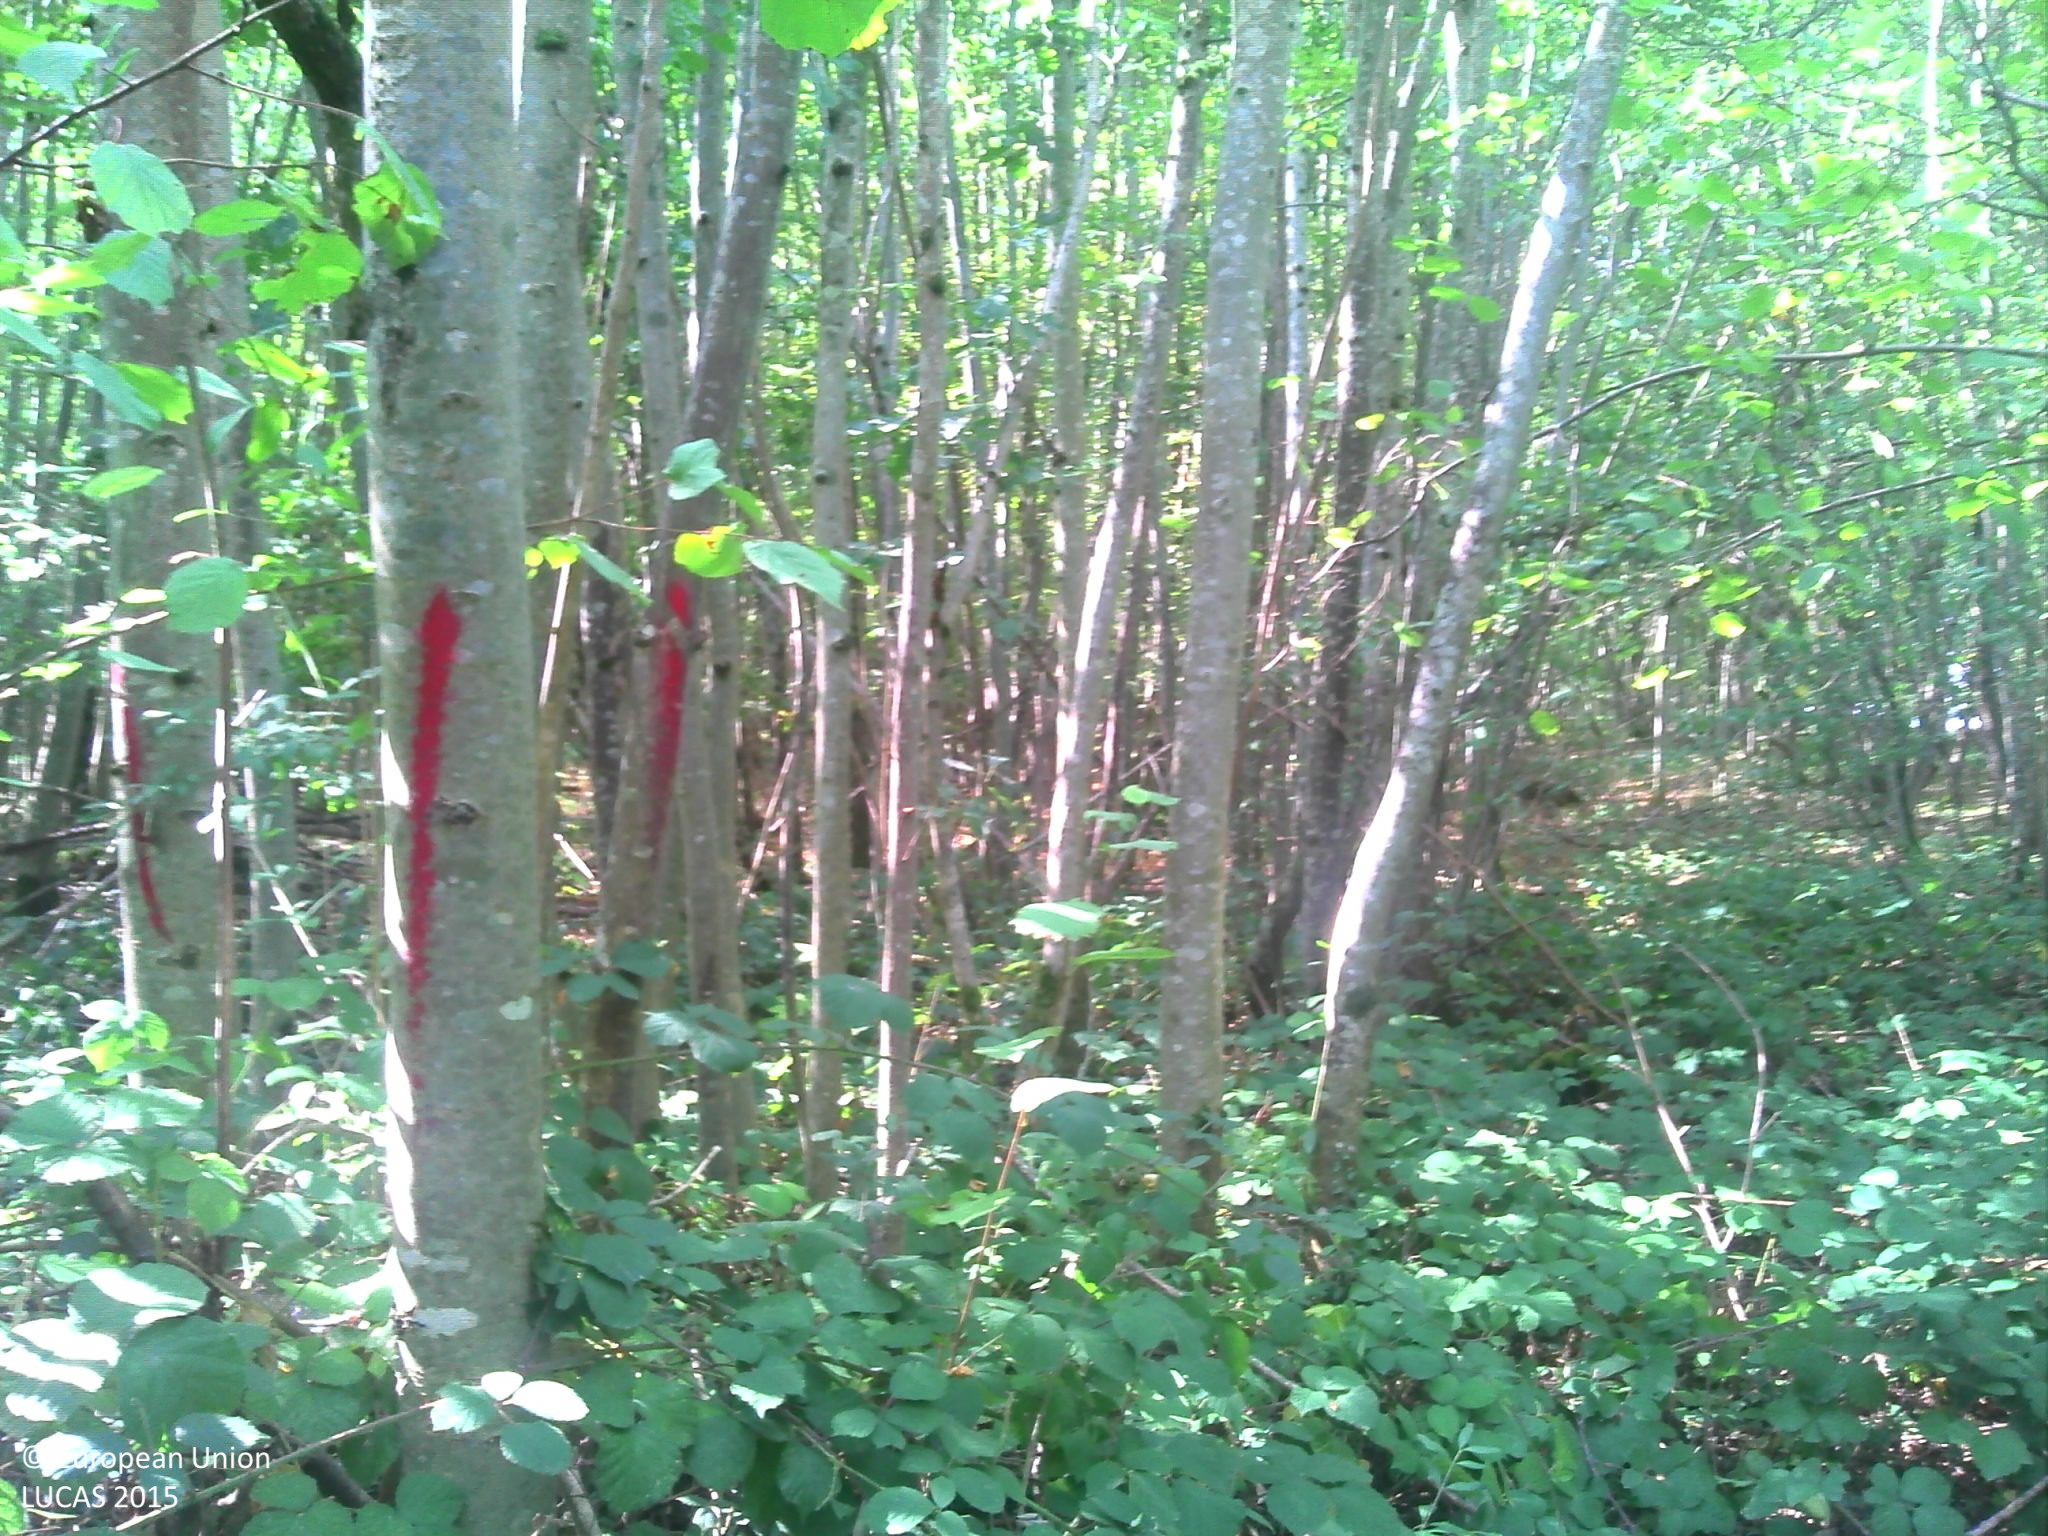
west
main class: Woodland
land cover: Broadleaved woodland
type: mesophytic deciduous forest
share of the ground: > 75 %
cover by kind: broadleaved forest trees 85 %, herbaceous plants 10 %, consolidated bare surface 5 %
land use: Forestry
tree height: > 5 m
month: September
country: FR
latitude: 48.8093
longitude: 6.2826
